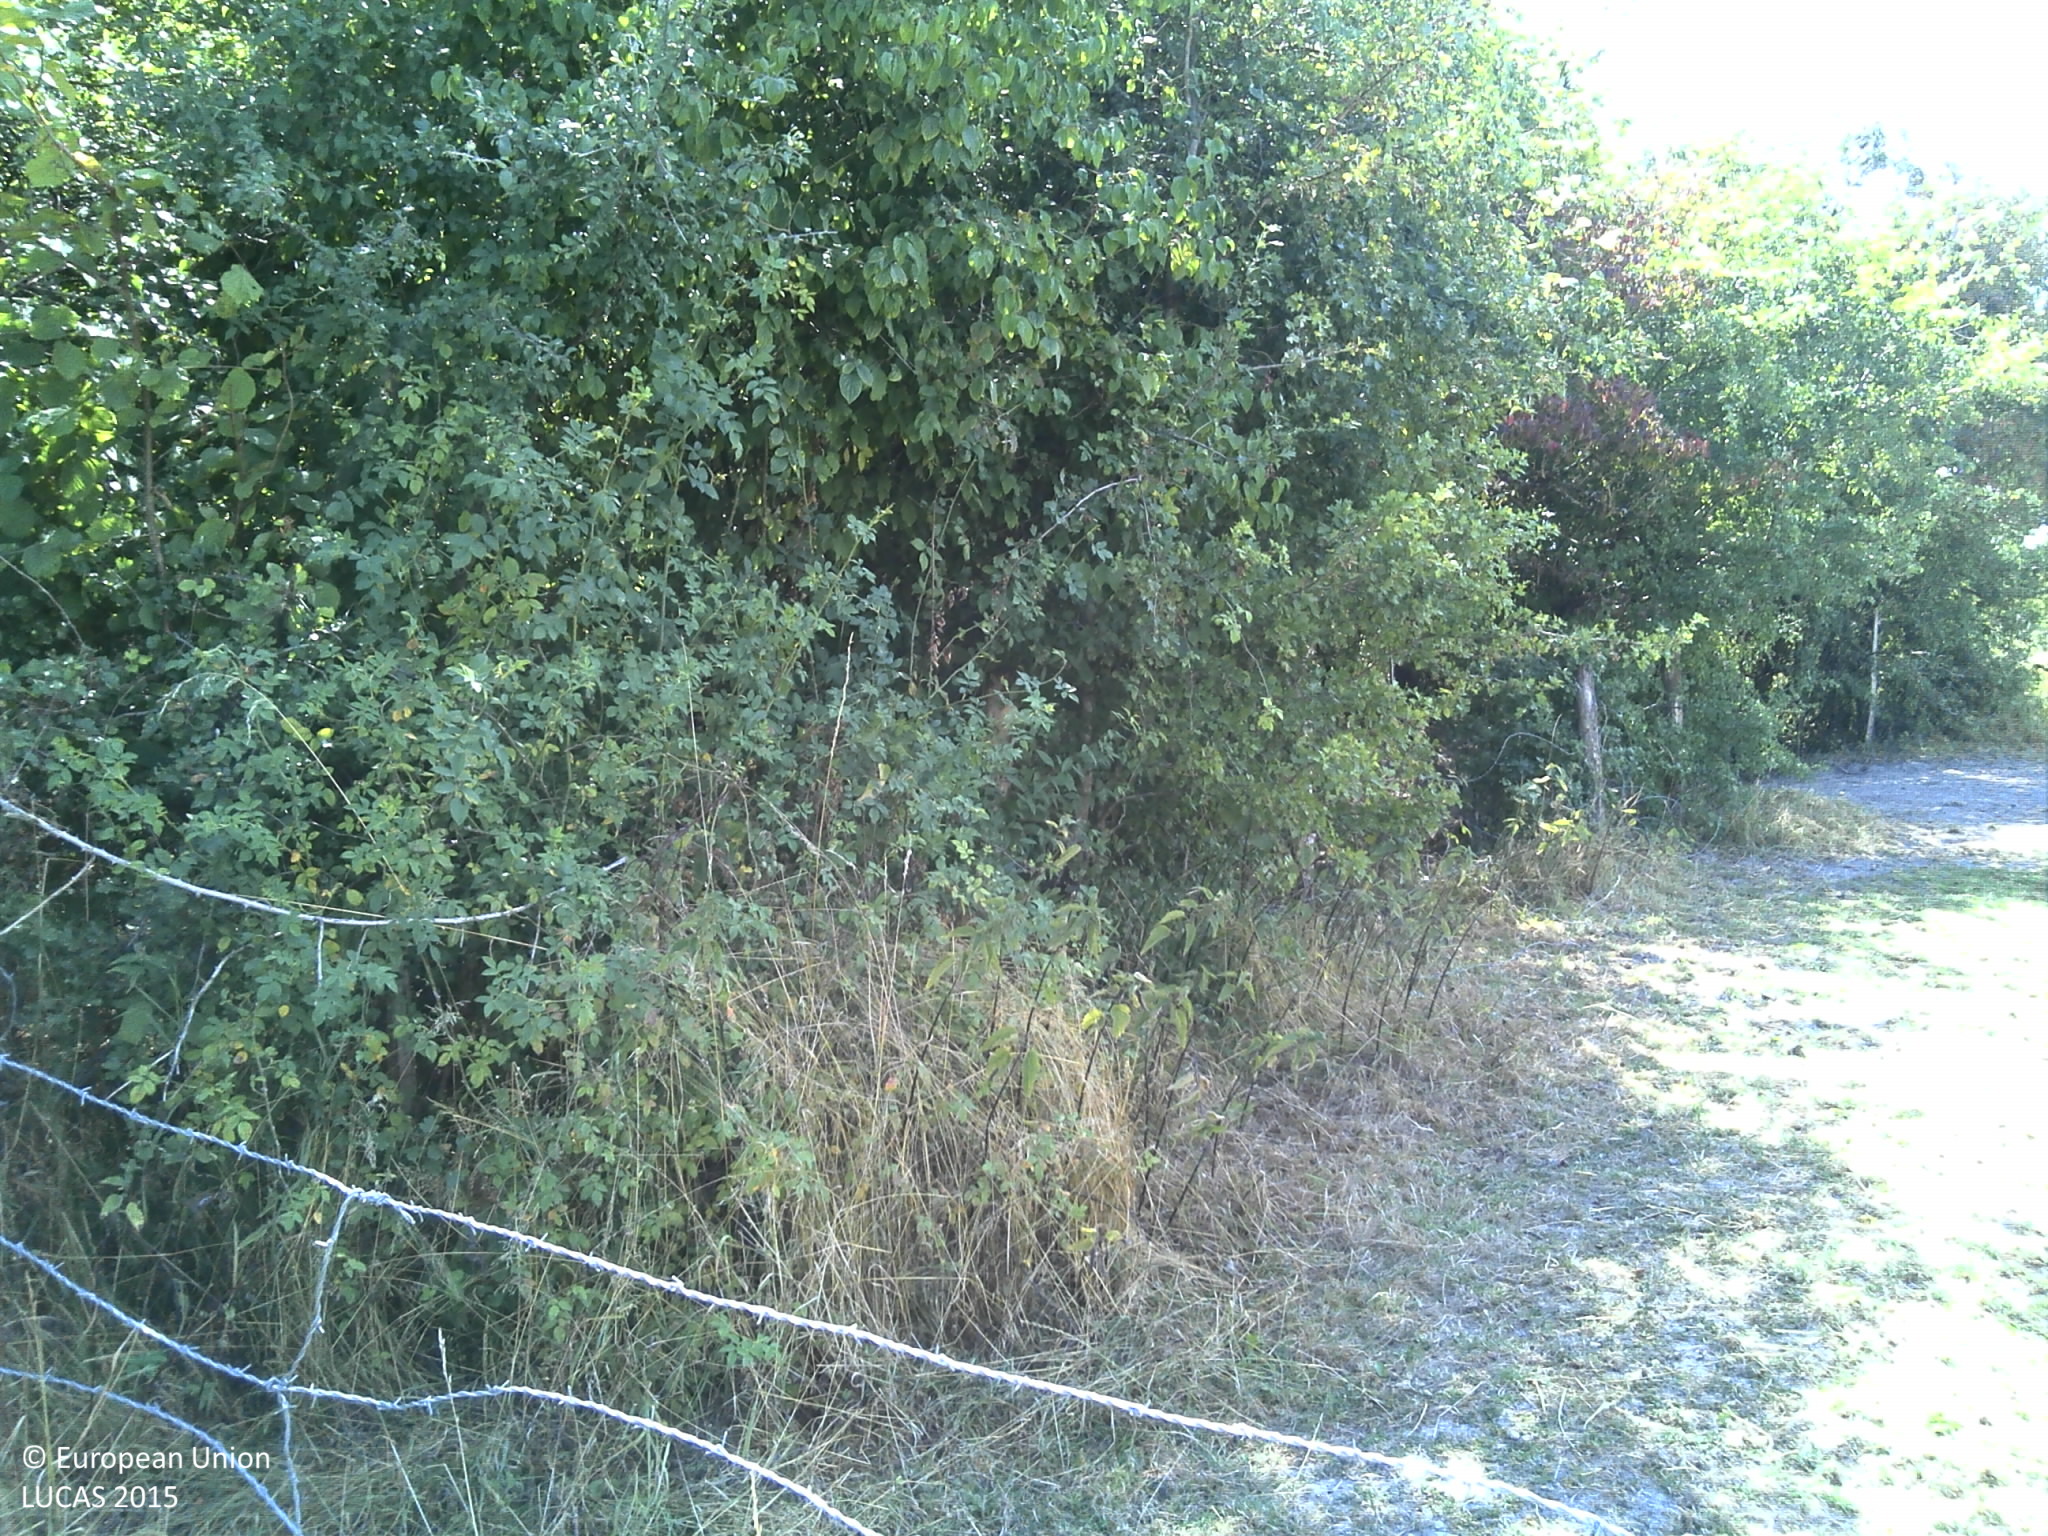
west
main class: Grassland
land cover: Grassland without tree/shrub cover
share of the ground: > 75 %
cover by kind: herbaceous plants 90 %, shrubs 5 %, consolidated bare surface 5 %
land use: Agriculture (excluding fallow land and kitchen gardens)
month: August
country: FR
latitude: 49.1812
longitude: 4.7703
